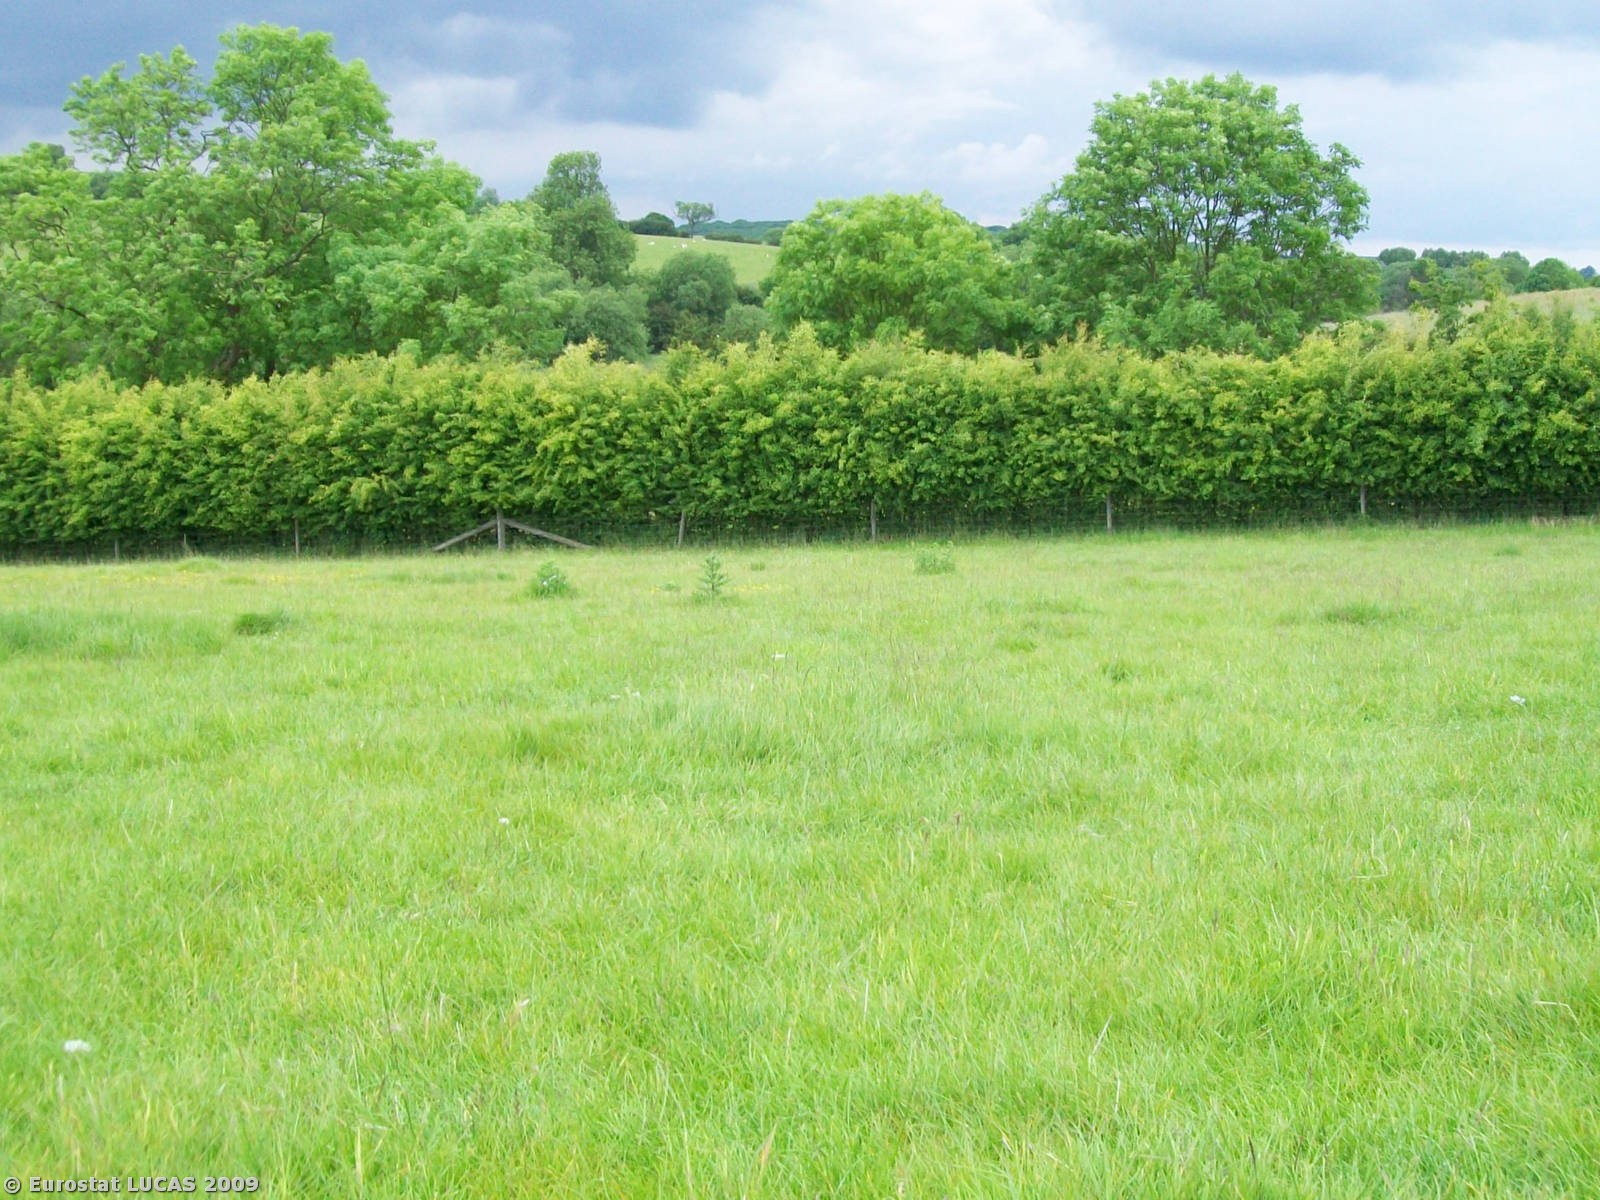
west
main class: Grassland
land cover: Grassland without tree/shrub cover
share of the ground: > 75 %
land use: Agriculture (excluding fallow land and kitchen gardens)
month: June
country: GB
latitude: 52.6083
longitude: -0.8070
